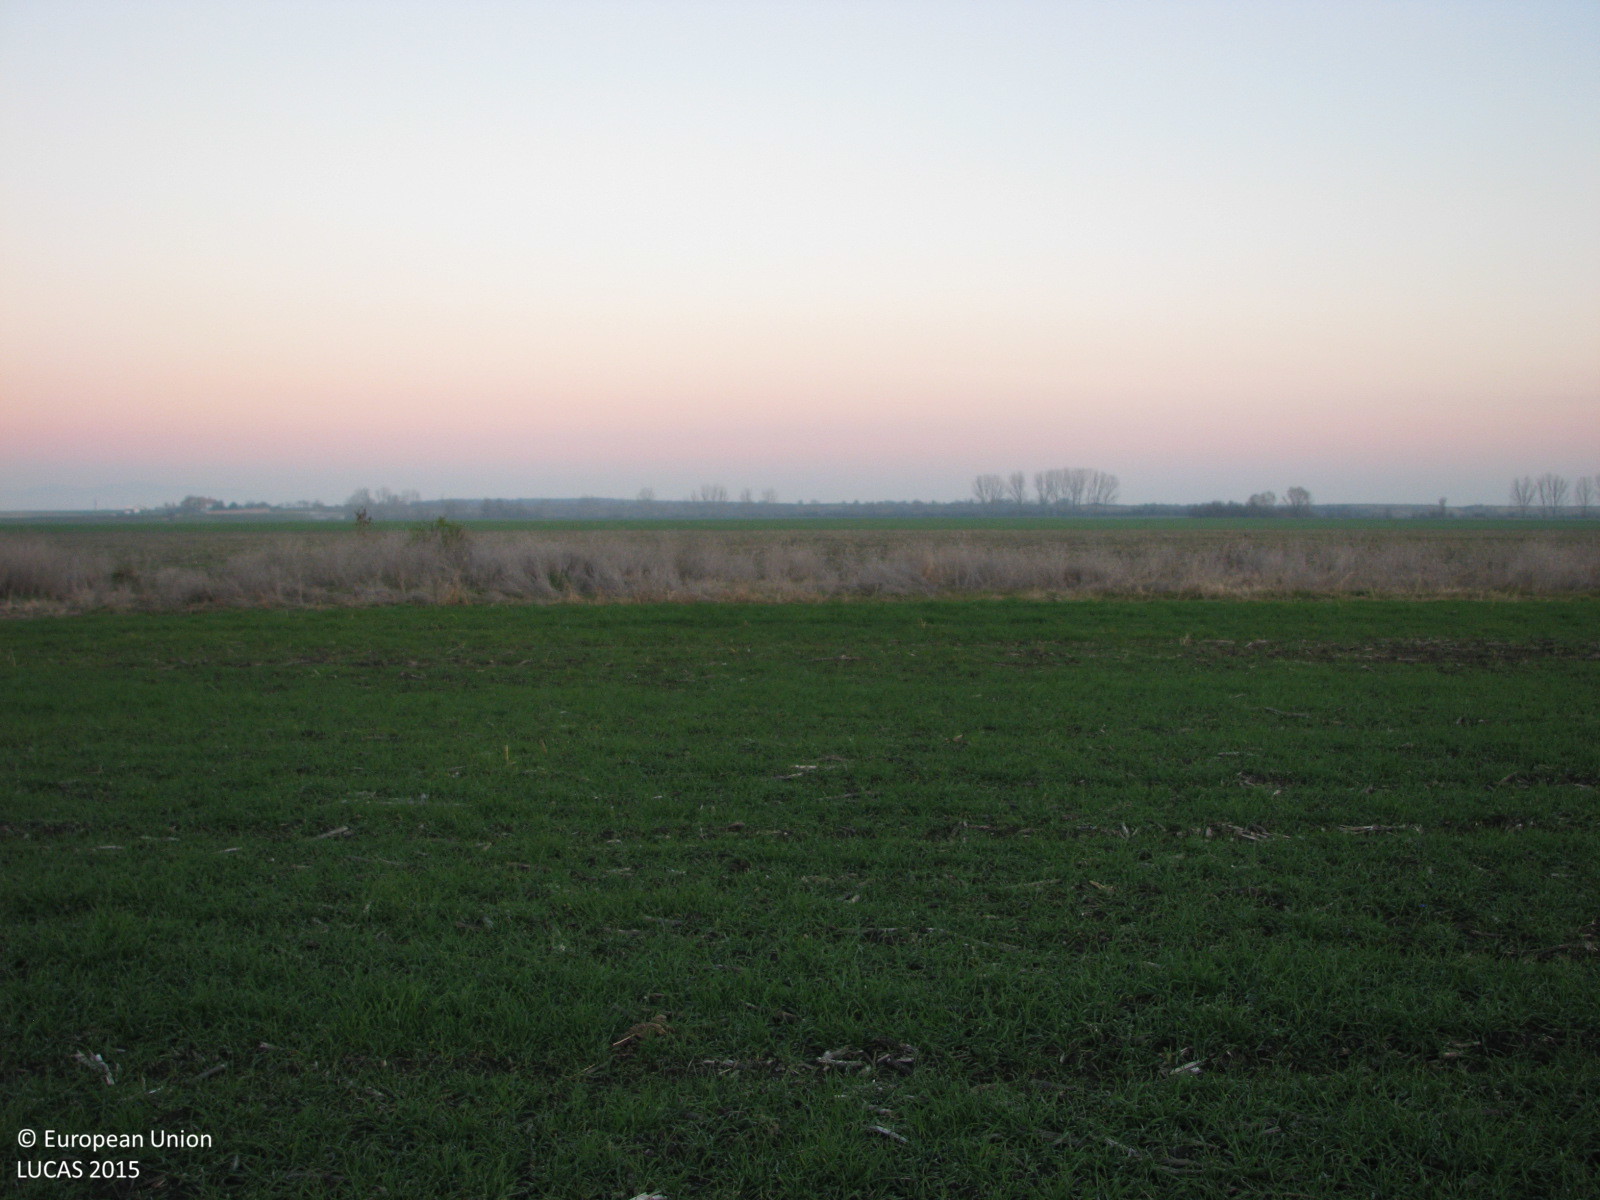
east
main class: Cropland
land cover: Common wheat
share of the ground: > 75 %
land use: Agriculture (excluding fallow land and kitchen gardens)
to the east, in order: Common wheat; Grass margins; Ditches and canals; Grass margins; Common wheat
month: December
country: BG
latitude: 42.2978
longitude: 25.0138
